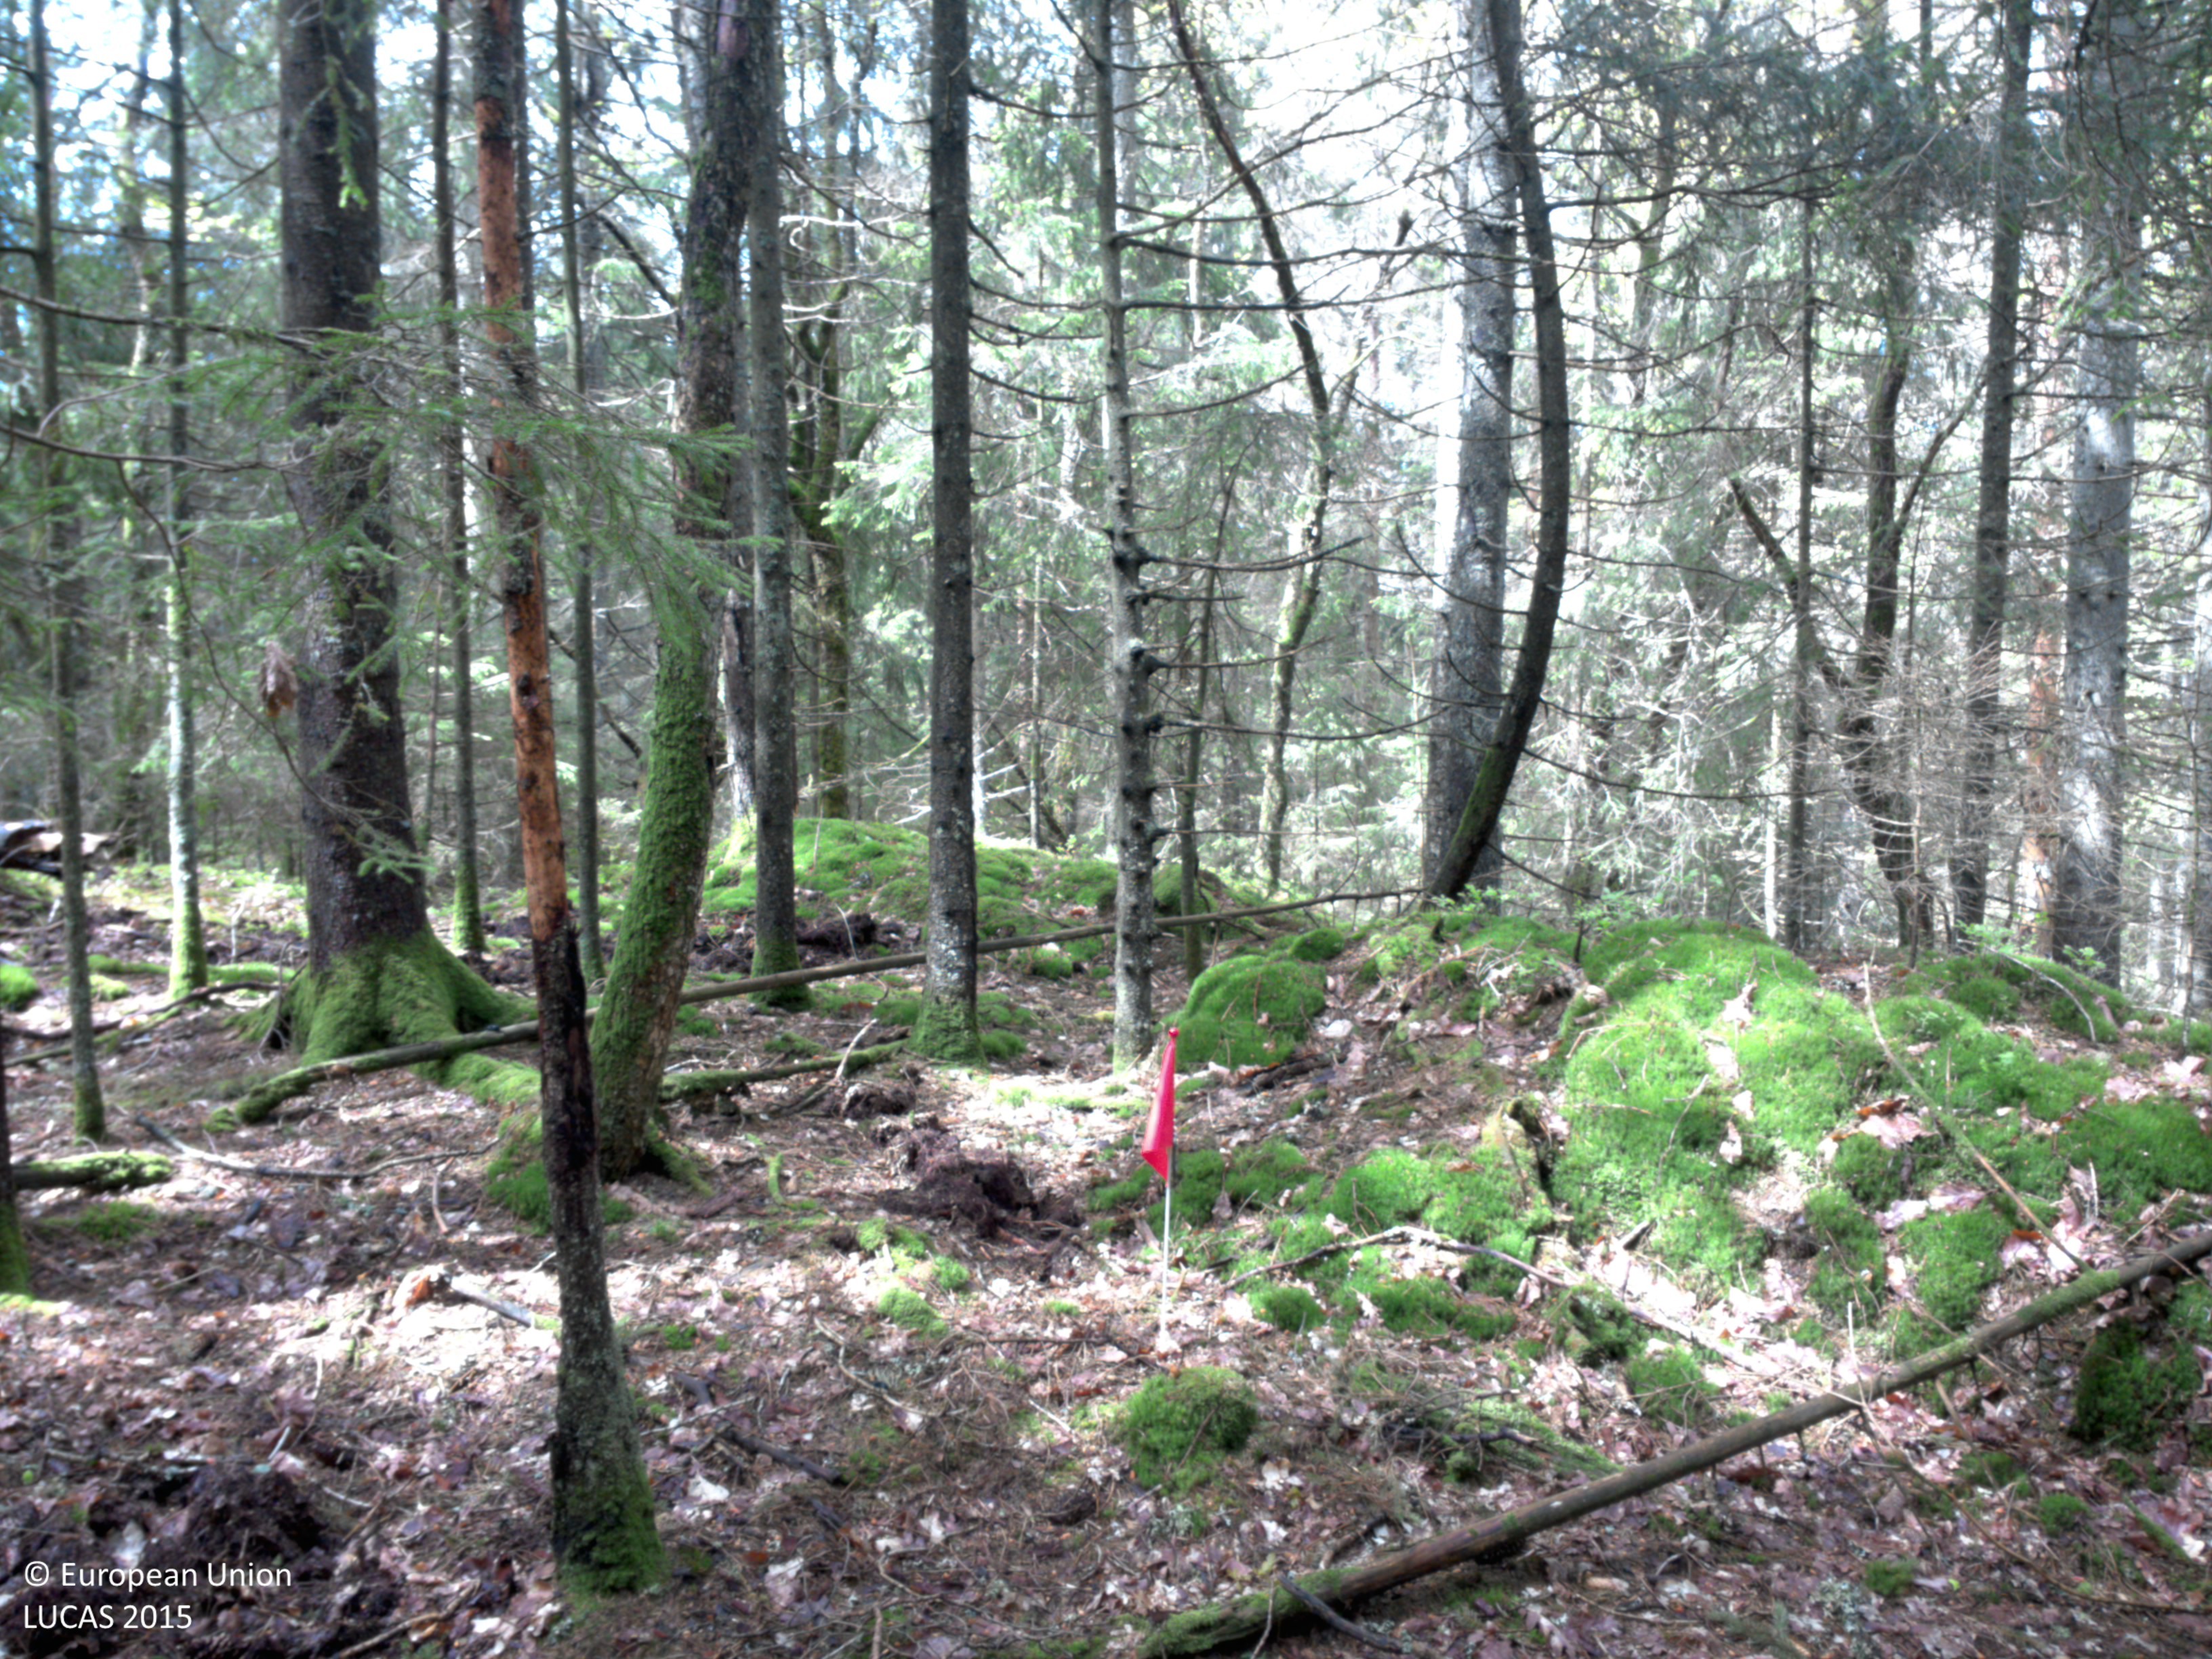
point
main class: Woodland
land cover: Spruce dominated coniferous woodland
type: boreal forest
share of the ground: 50 - 75 %
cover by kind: coniferous forest trees 65 %, herbaceous plants 35 %
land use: Forestry
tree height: > 5 m
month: June
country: SE
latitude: 57.9711
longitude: 11.9744
